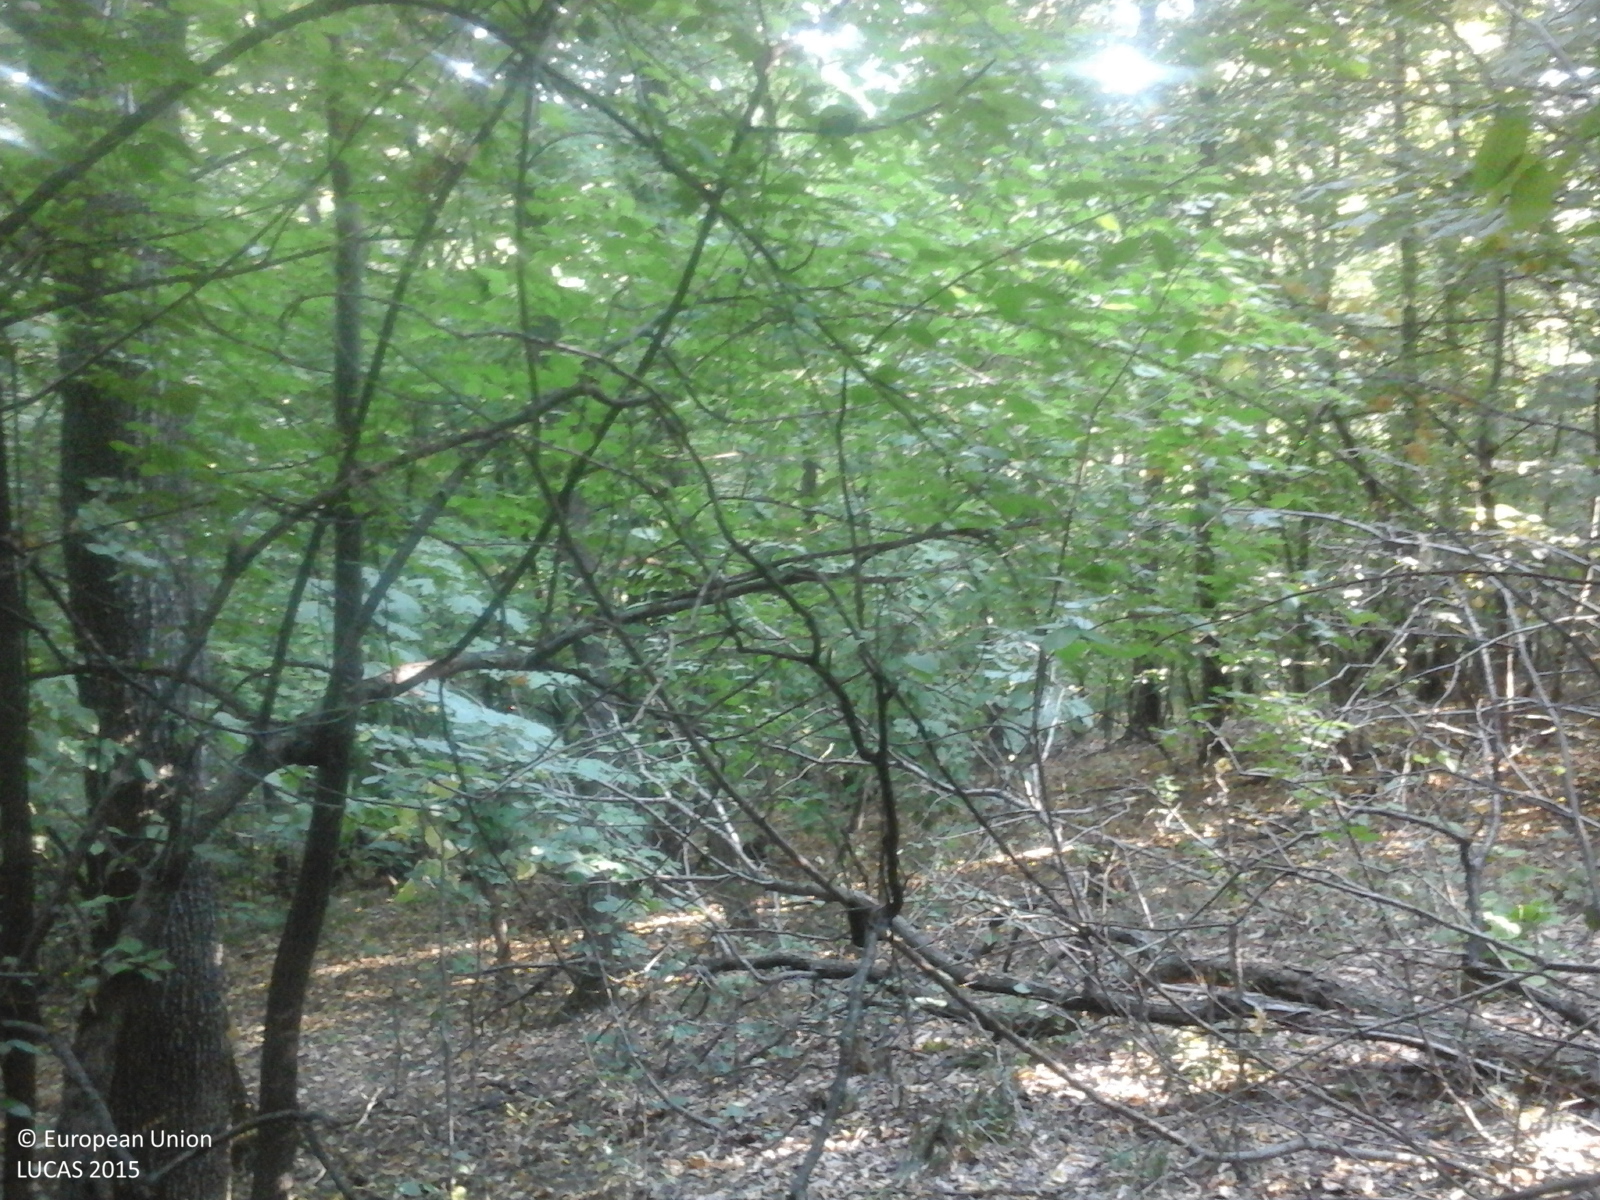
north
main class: Woodland
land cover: Broadleaved woodland
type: mesophytic deciduous forest
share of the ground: > 75 %
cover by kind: broadleaved forest trees 100 %
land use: Forestry
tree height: > 5 m
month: July
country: RO
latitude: 46.2918
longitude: 27.8384
